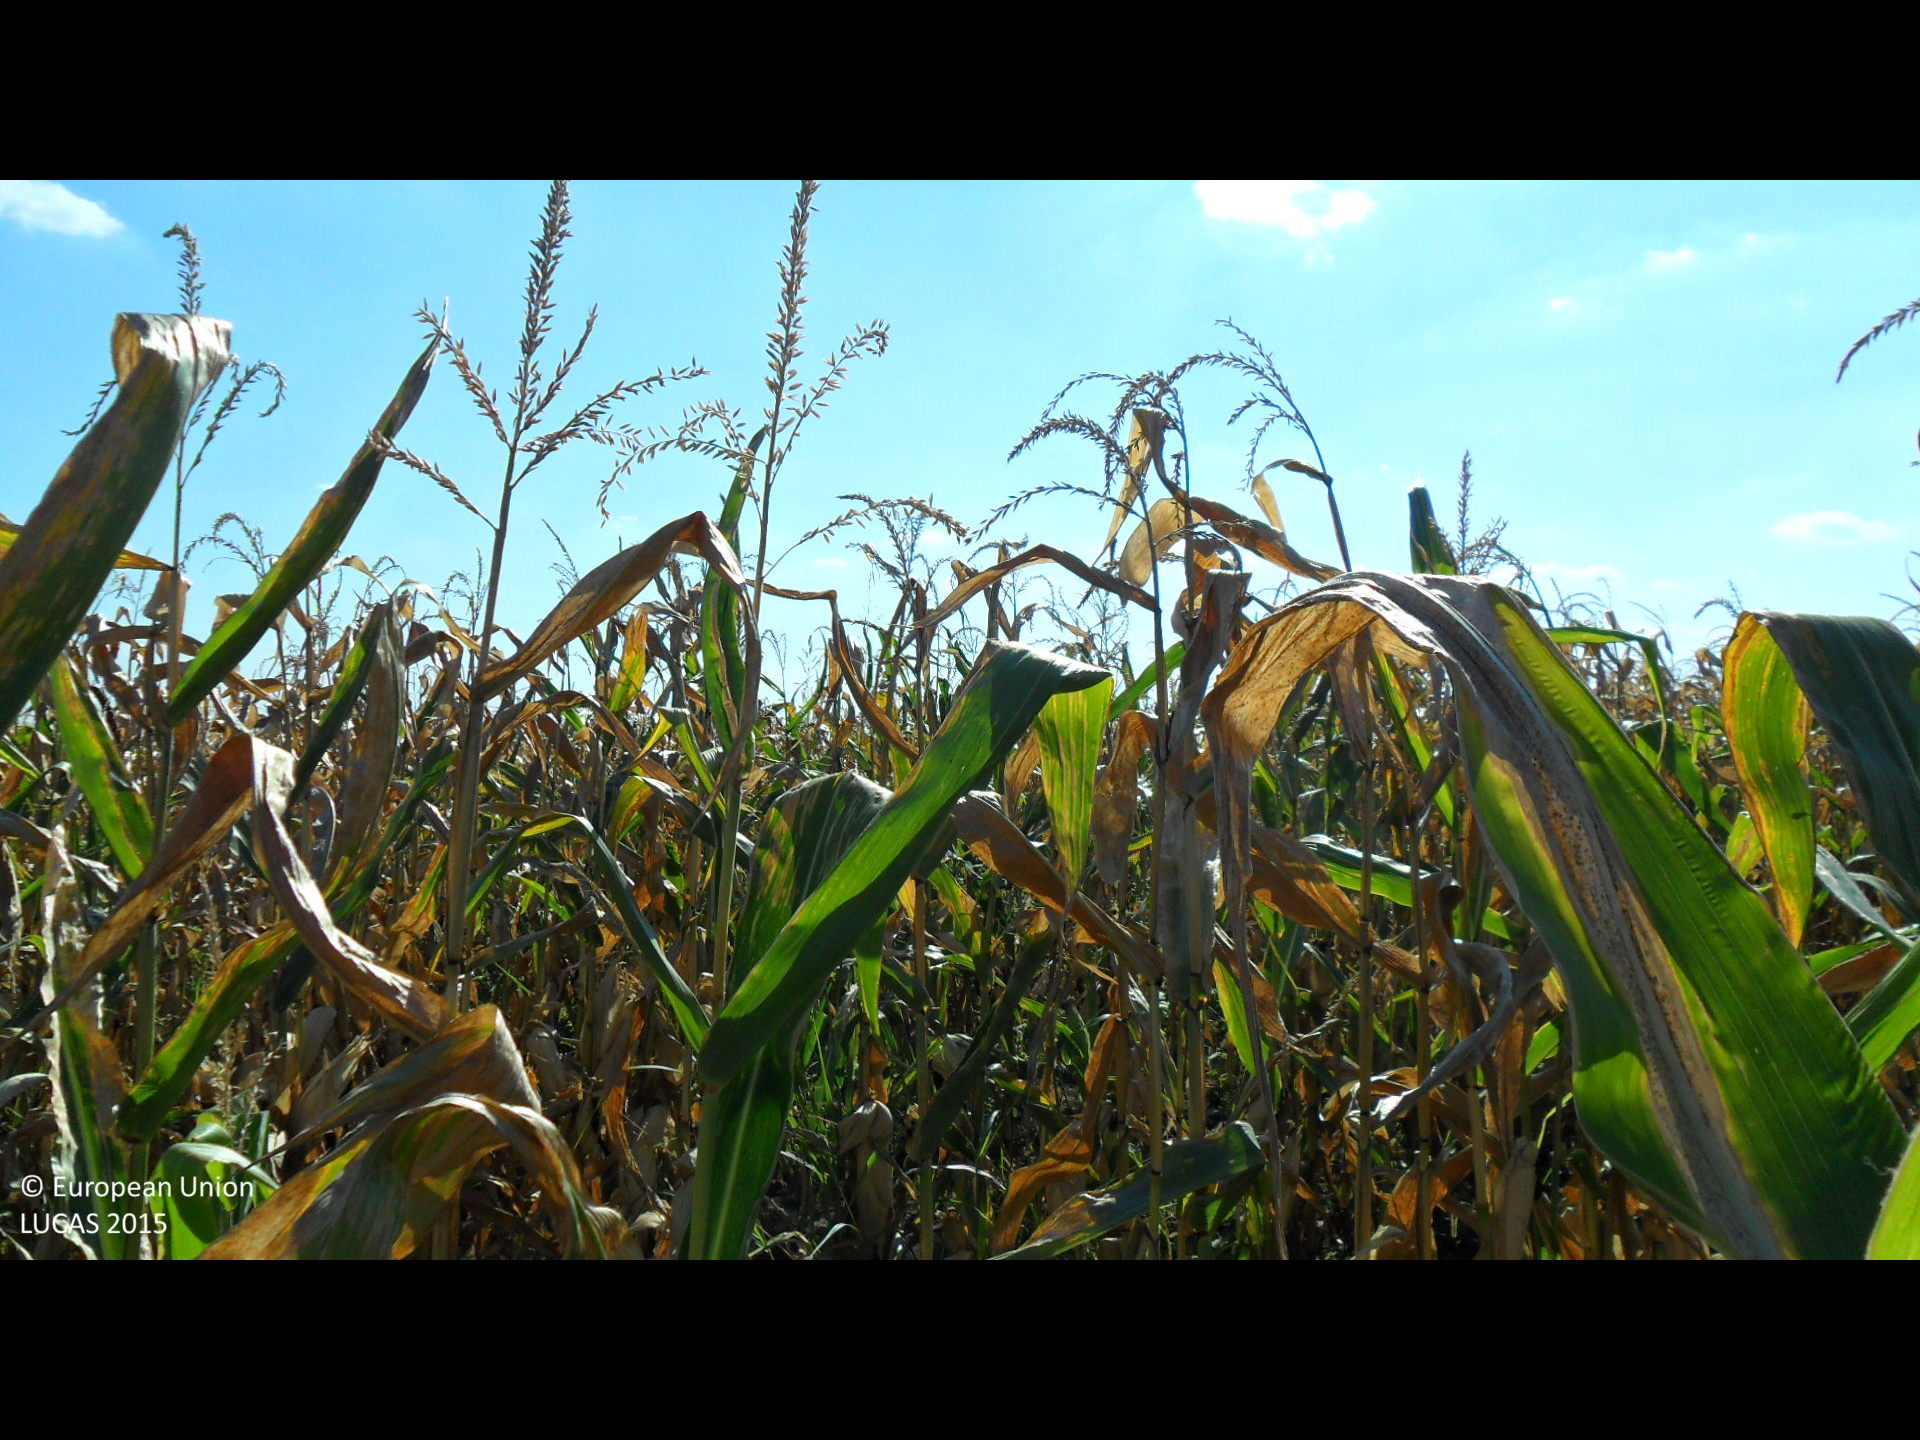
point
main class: Cropland
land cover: Maize
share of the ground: > 75 %
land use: Agriculture (excluding fallow land and kitchen gardens)
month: August
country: BG
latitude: 43.4865
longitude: 26.3353
